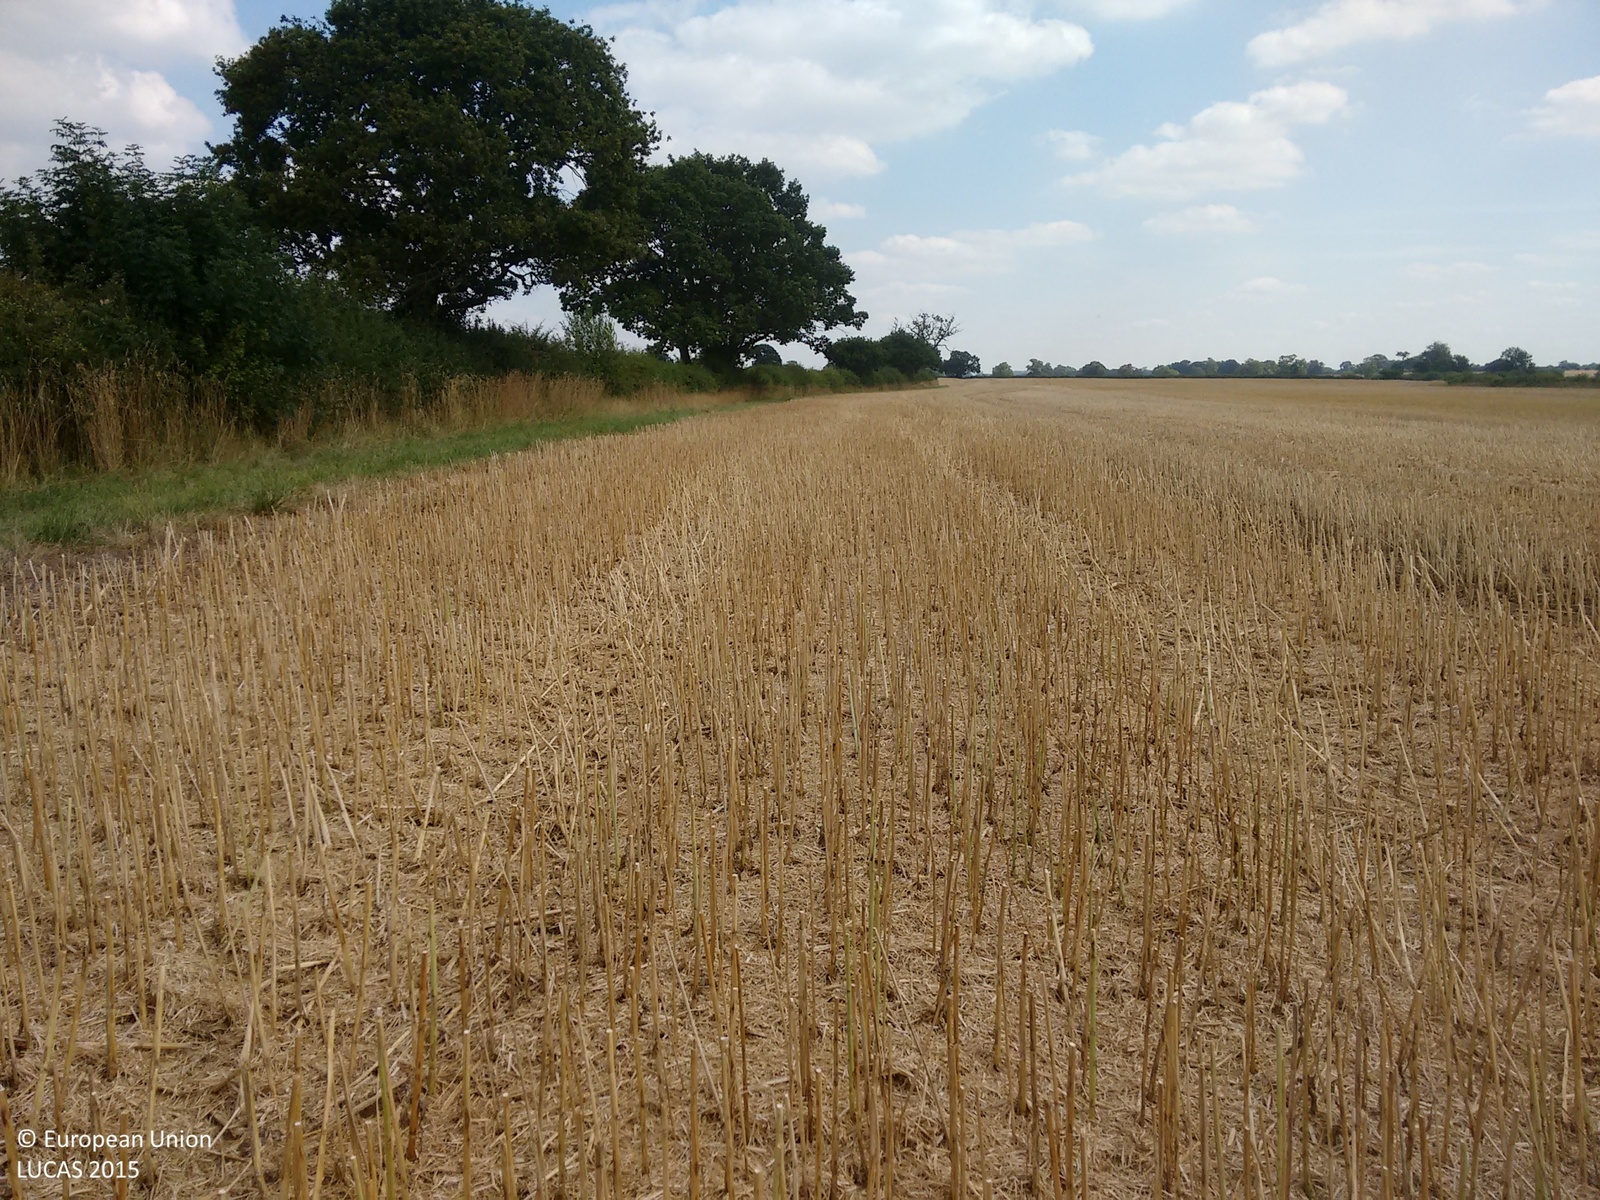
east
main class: Cropland
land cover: Rape and turnip rape
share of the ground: > 75 %
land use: Agriculture (excluding fallow land and kitchen gardens)
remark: Harvested field
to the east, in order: Rape and turnip rape
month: August
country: GB
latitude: 52.6011
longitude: -1.4635
